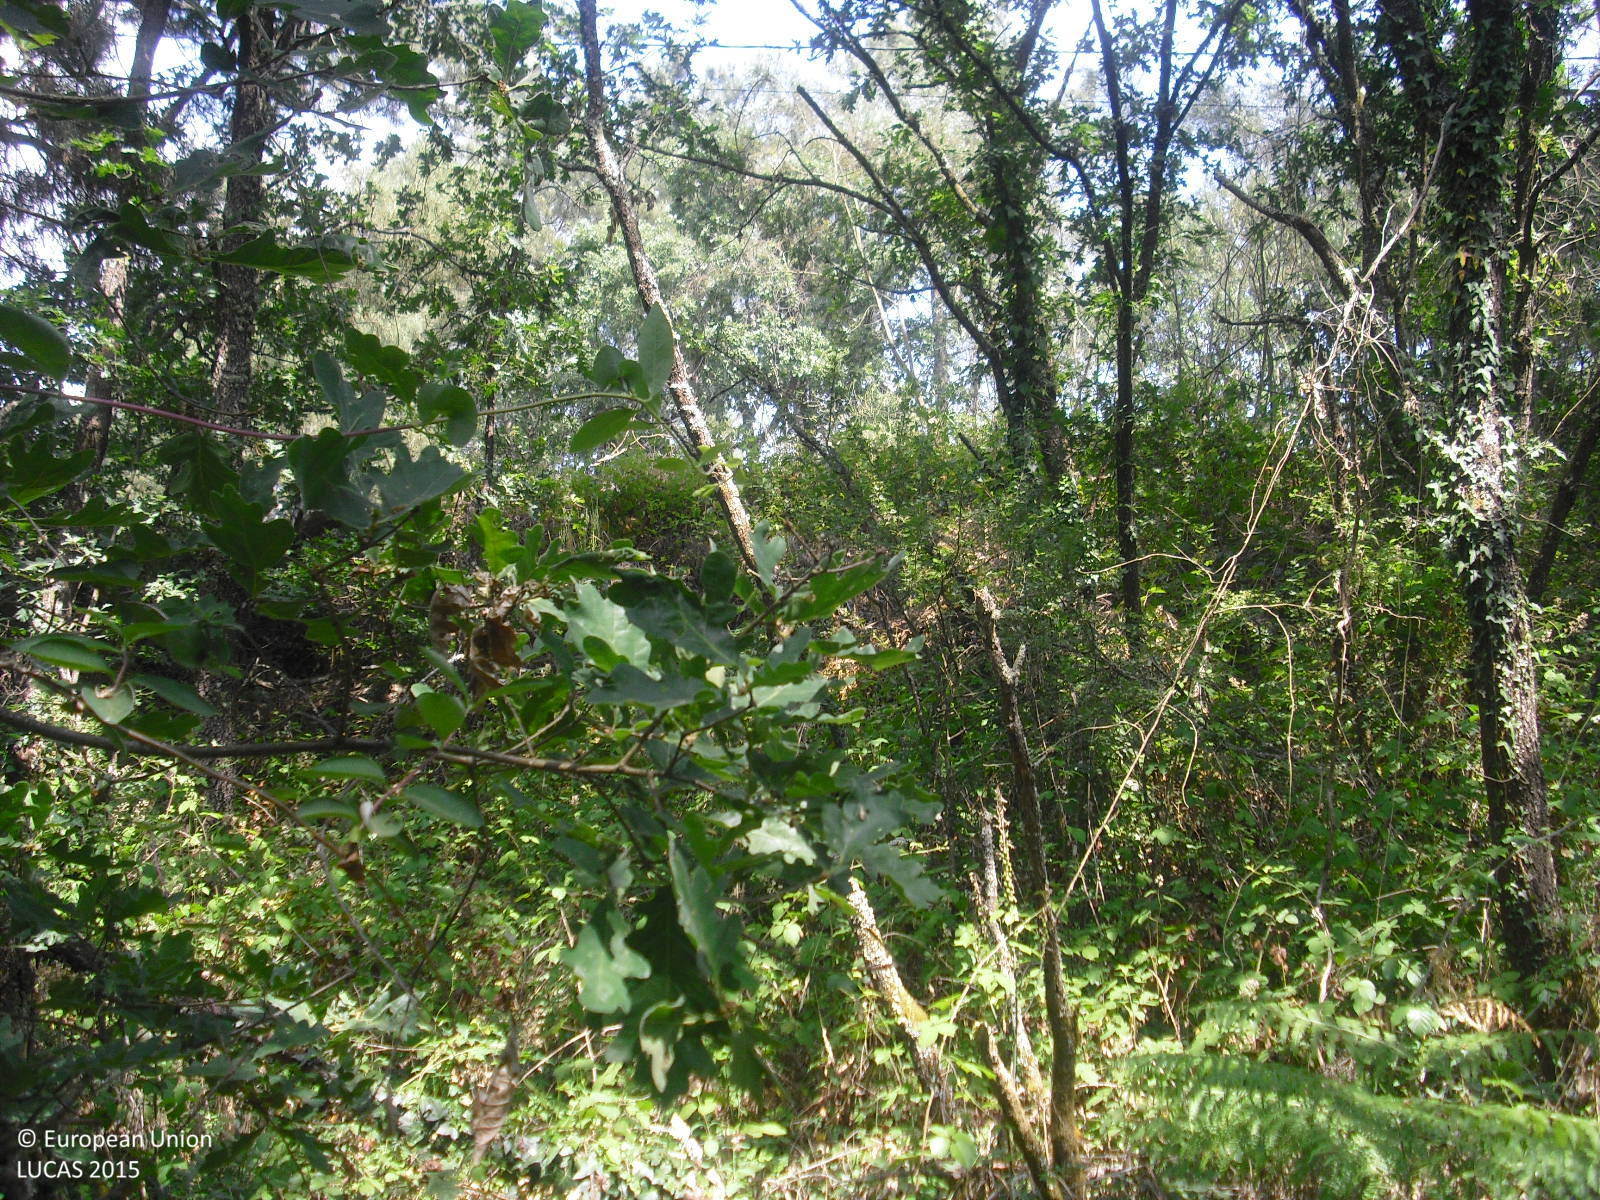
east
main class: Woodland
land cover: Broadleaved woodland
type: acidophilous oak and oak-birch forest
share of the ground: > 75 %
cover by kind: broadleaved forest trees 60 %, coniferous forest trees 20 %, shrubs 20 %
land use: Semi-natural and natural areas not in use
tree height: > 5 m
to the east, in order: Broadleaved woodland; Electric lines; Pine dominated mixed woodland; Shruby margins; Fences; Paved roads, cycling and walking lanes; Ditches and canals; Shruby margins; Pine dominated mixed woodland; Rock outcrops; Pine dominated mixed woodland; Shrubland with sparse tree cover; Dry stone walls; Fences; Vineyards; Grassland with sparse tree/shrub cover; Artificial constructions in urban areas; Grassland with sparse tree/shrub cover; Rock outcrops; Grassland with sparse tree/shrub cover; Dry stone walls; Rock outcrops; Pine dominated mixed woodland; Shrubland with sparse tree cover; Electric lines; Shrubland with sparse tree cover; Pine dominated mixed woodland; Broadleaved woodland; Rock outcrops; Broadleaved woodland
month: June
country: ES
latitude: 42.2730
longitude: -7.8383
